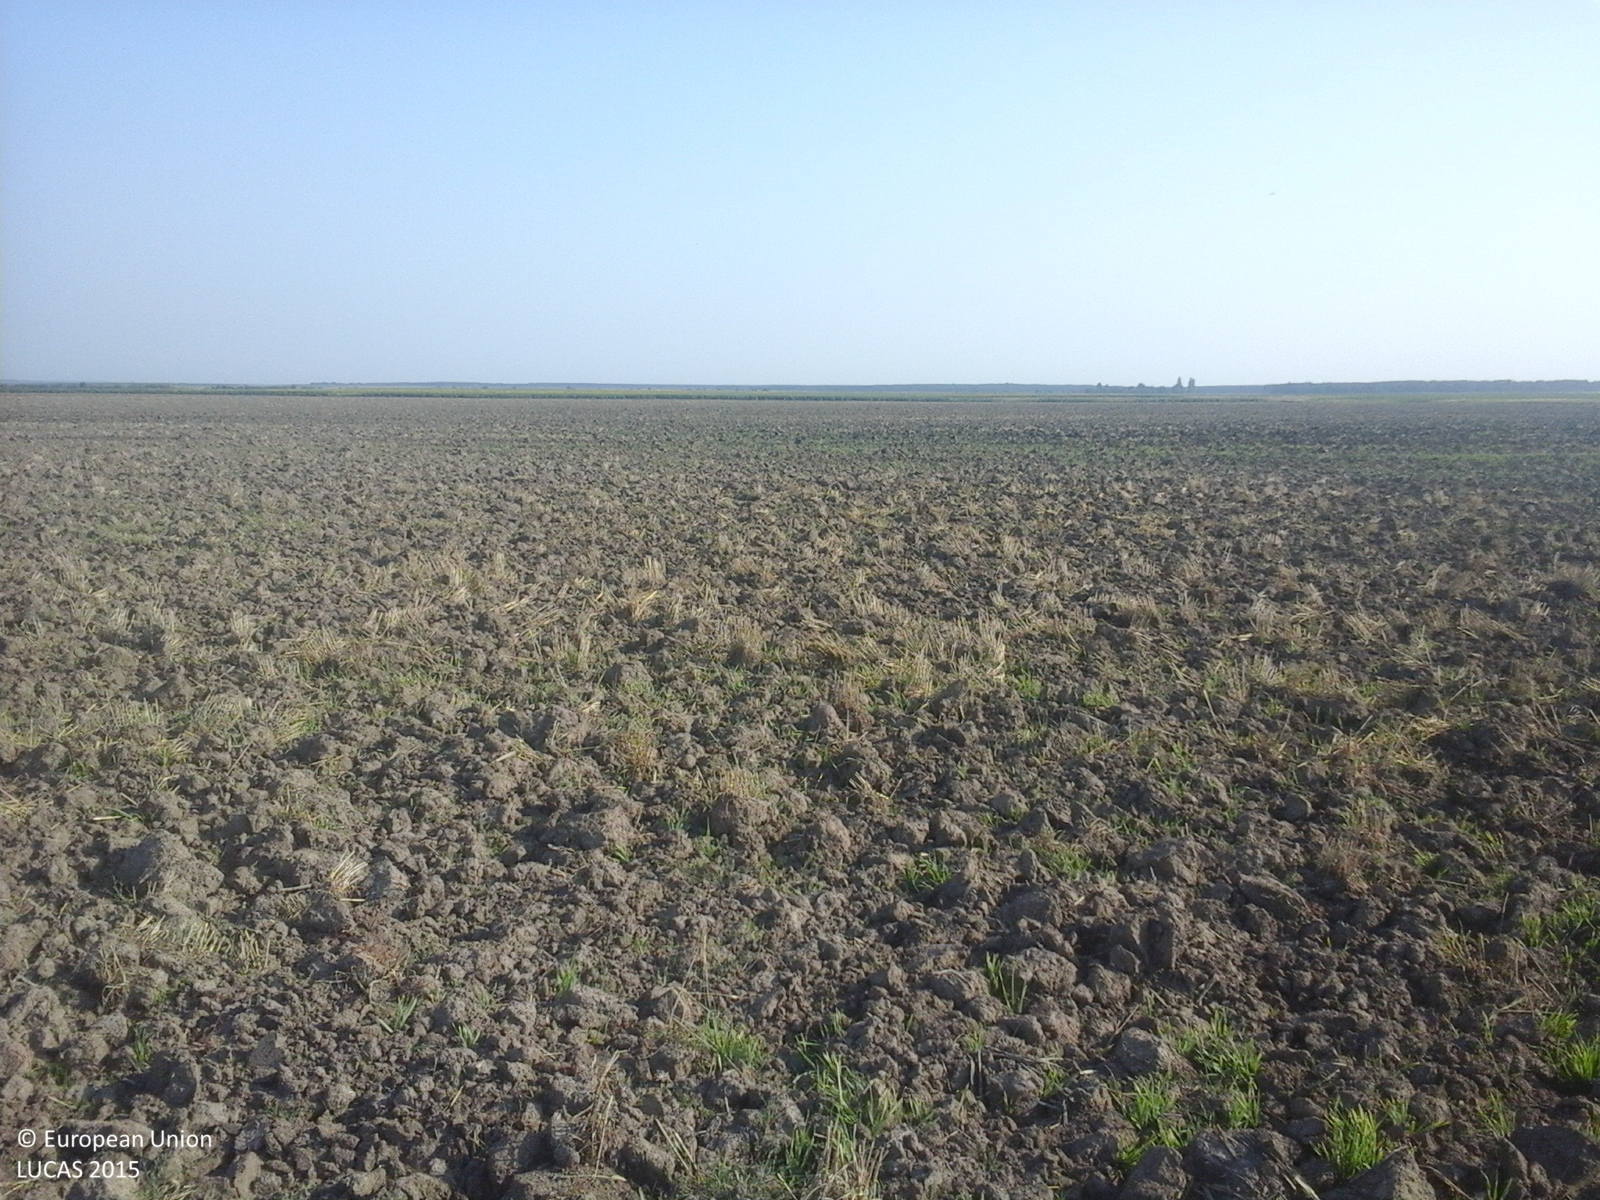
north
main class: Cropland
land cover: Rye
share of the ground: < 10 %
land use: Agriculture (excluding fallow land and kitchen gardens)
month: July
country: RO
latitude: 44.4977
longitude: 24.7527
